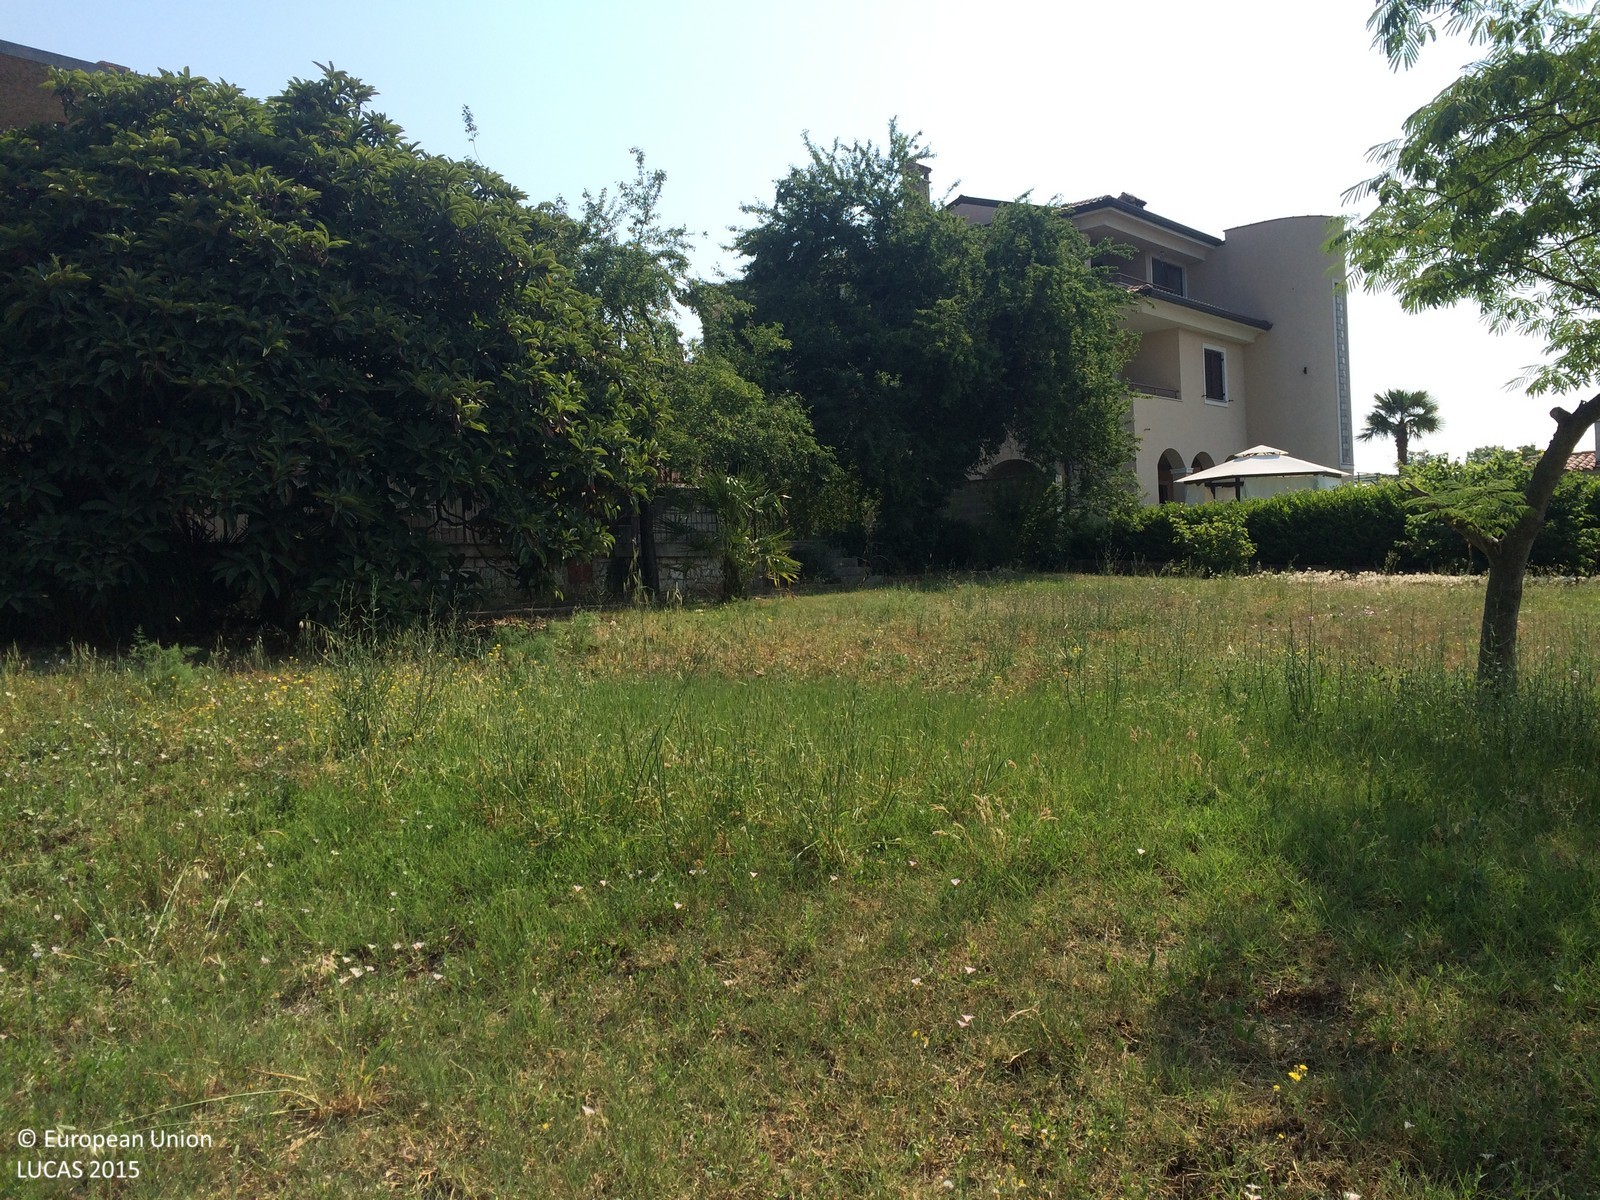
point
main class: Grassland
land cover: Grassland without tree/shrub cover
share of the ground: > 75 %
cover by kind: herbaceous plants 100 %
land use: Residential
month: June
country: HR
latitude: 45.0799
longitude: 13.6659
